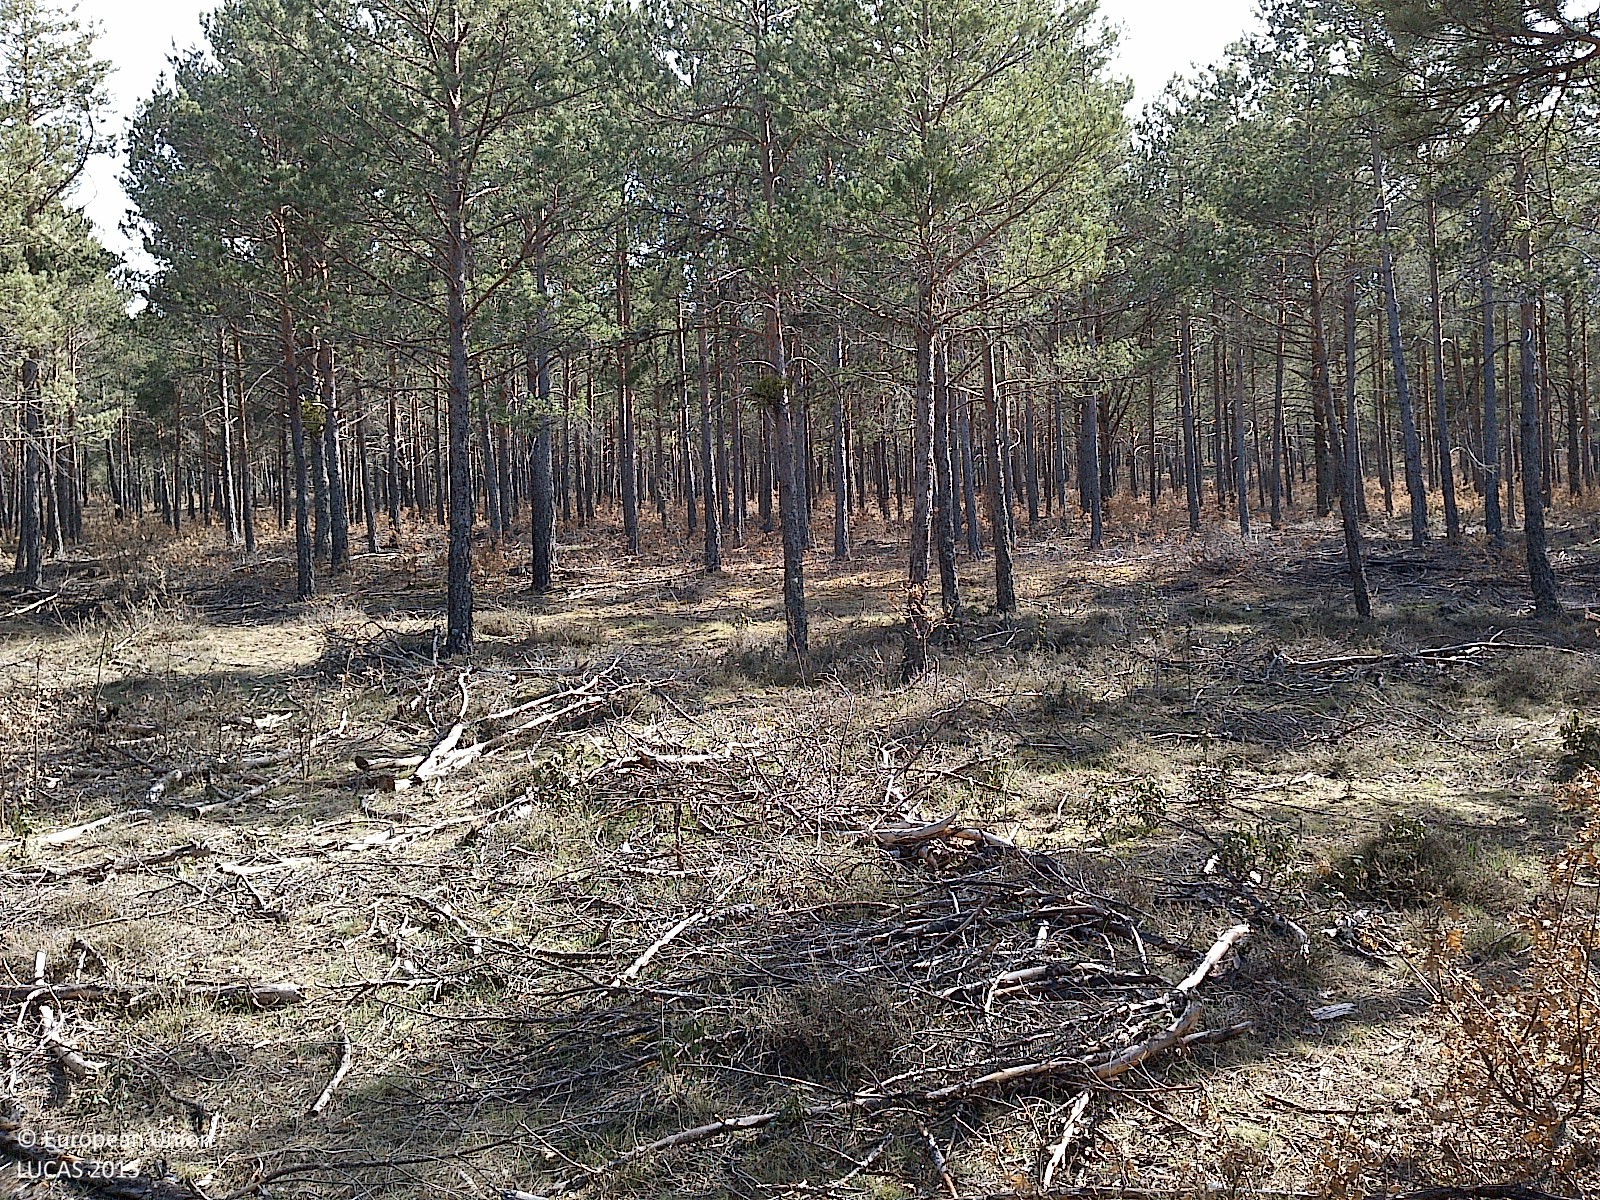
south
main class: Woodland
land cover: Pine dominated coniferous woodland
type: coniferous forest of the mediterranean region
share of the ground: > 75 %
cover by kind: coniferous forest trees 85 %, herbaceous plants 10 %, shrubs 5 %
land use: Forestry
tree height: > 5 m
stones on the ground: < 10 %
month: April
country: ES
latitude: 41.8535
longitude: -2.8231
